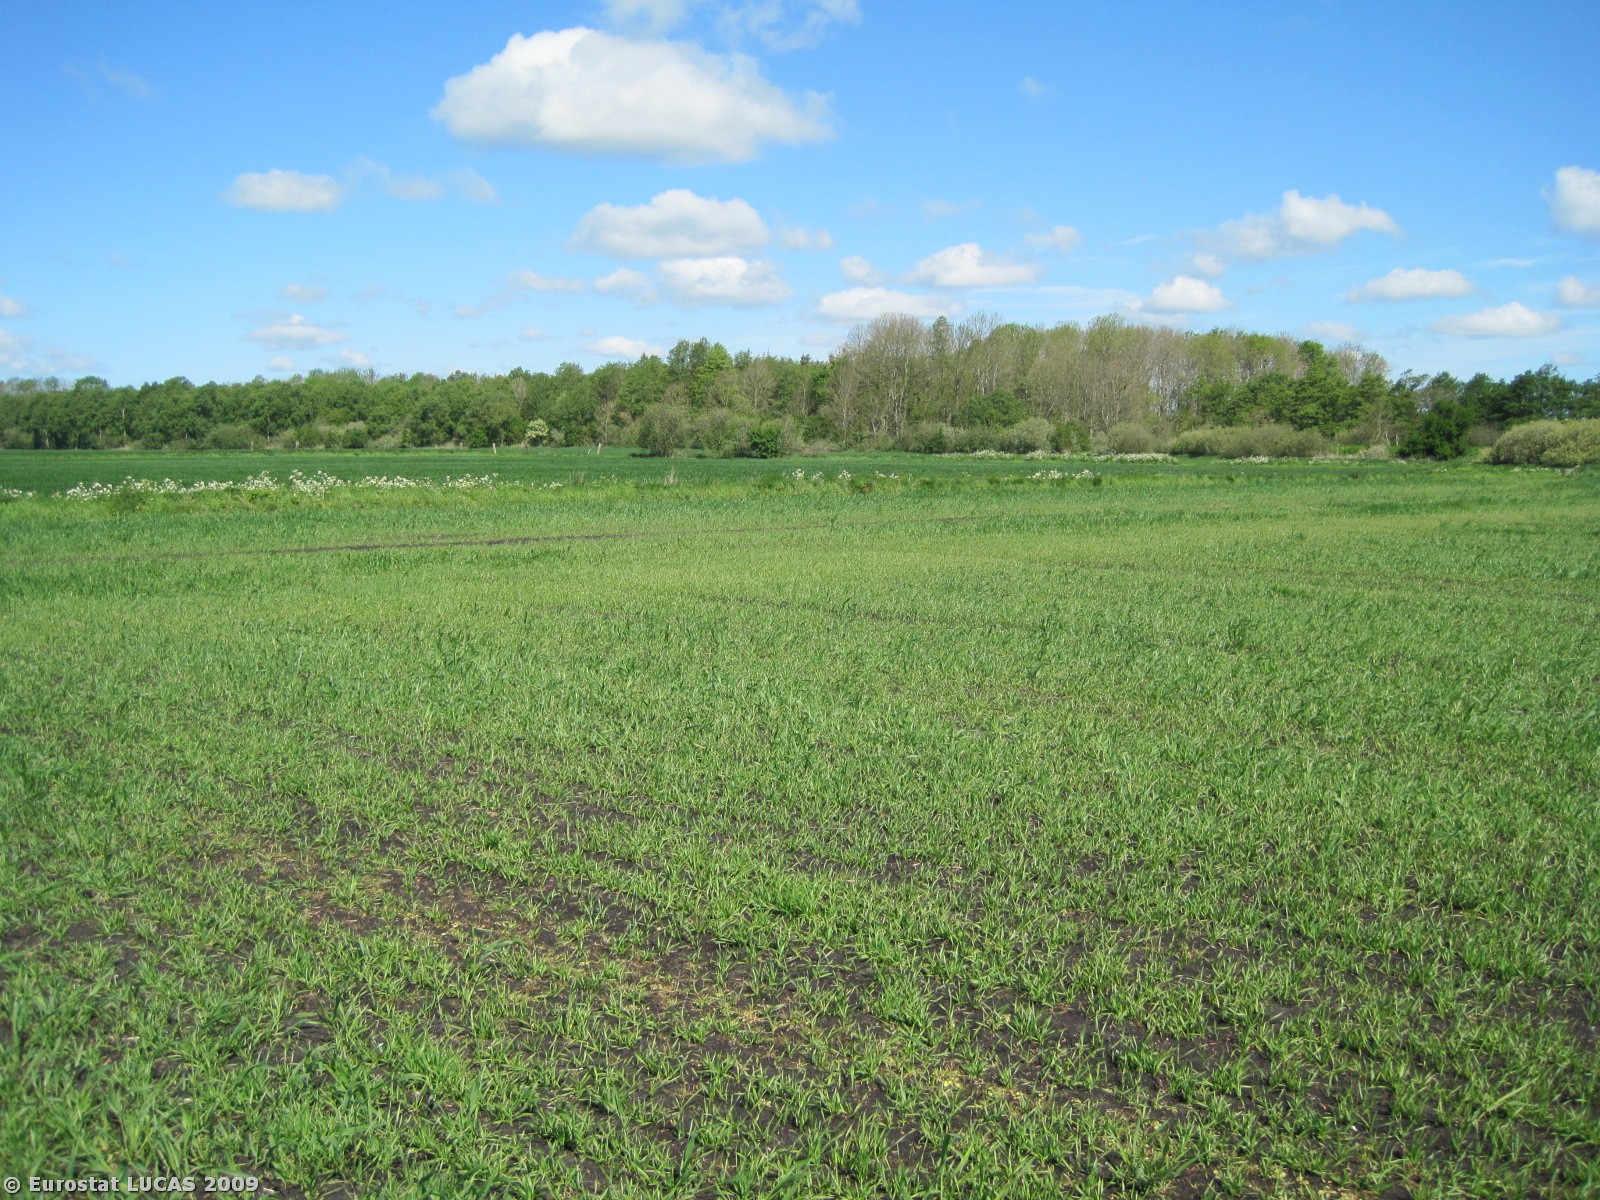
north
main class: Cropland
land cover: Barley
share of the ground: 50 - 75 %
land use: Agriculture (excluding fallow land and kitchen gardens)
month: May
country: DK
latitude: 56.9068
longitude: 10.0820
